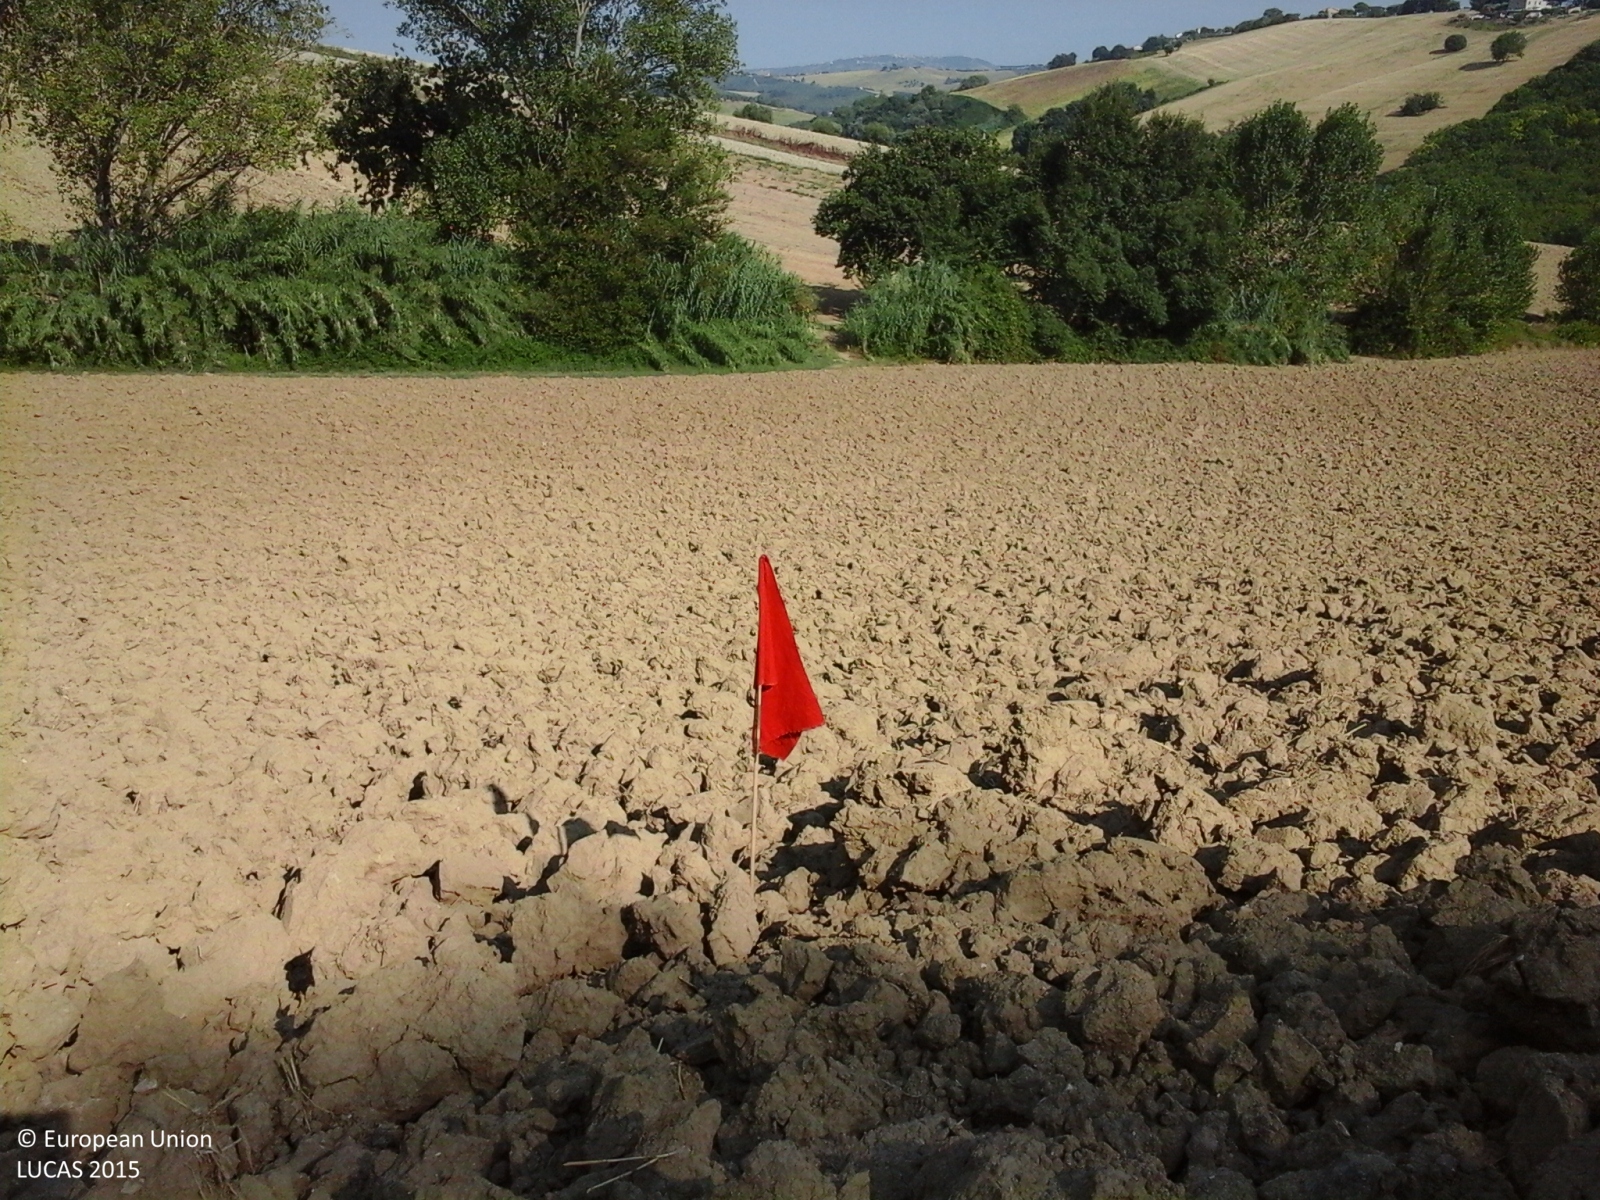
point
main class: Cropland
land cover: Durum wheat
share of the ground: < 10 %
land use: Agriculture (excluding fallow land and kitchen gardens)
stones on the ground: 10 - 25 %
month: August
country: IT
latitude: 43.4466
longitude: 13.3896
